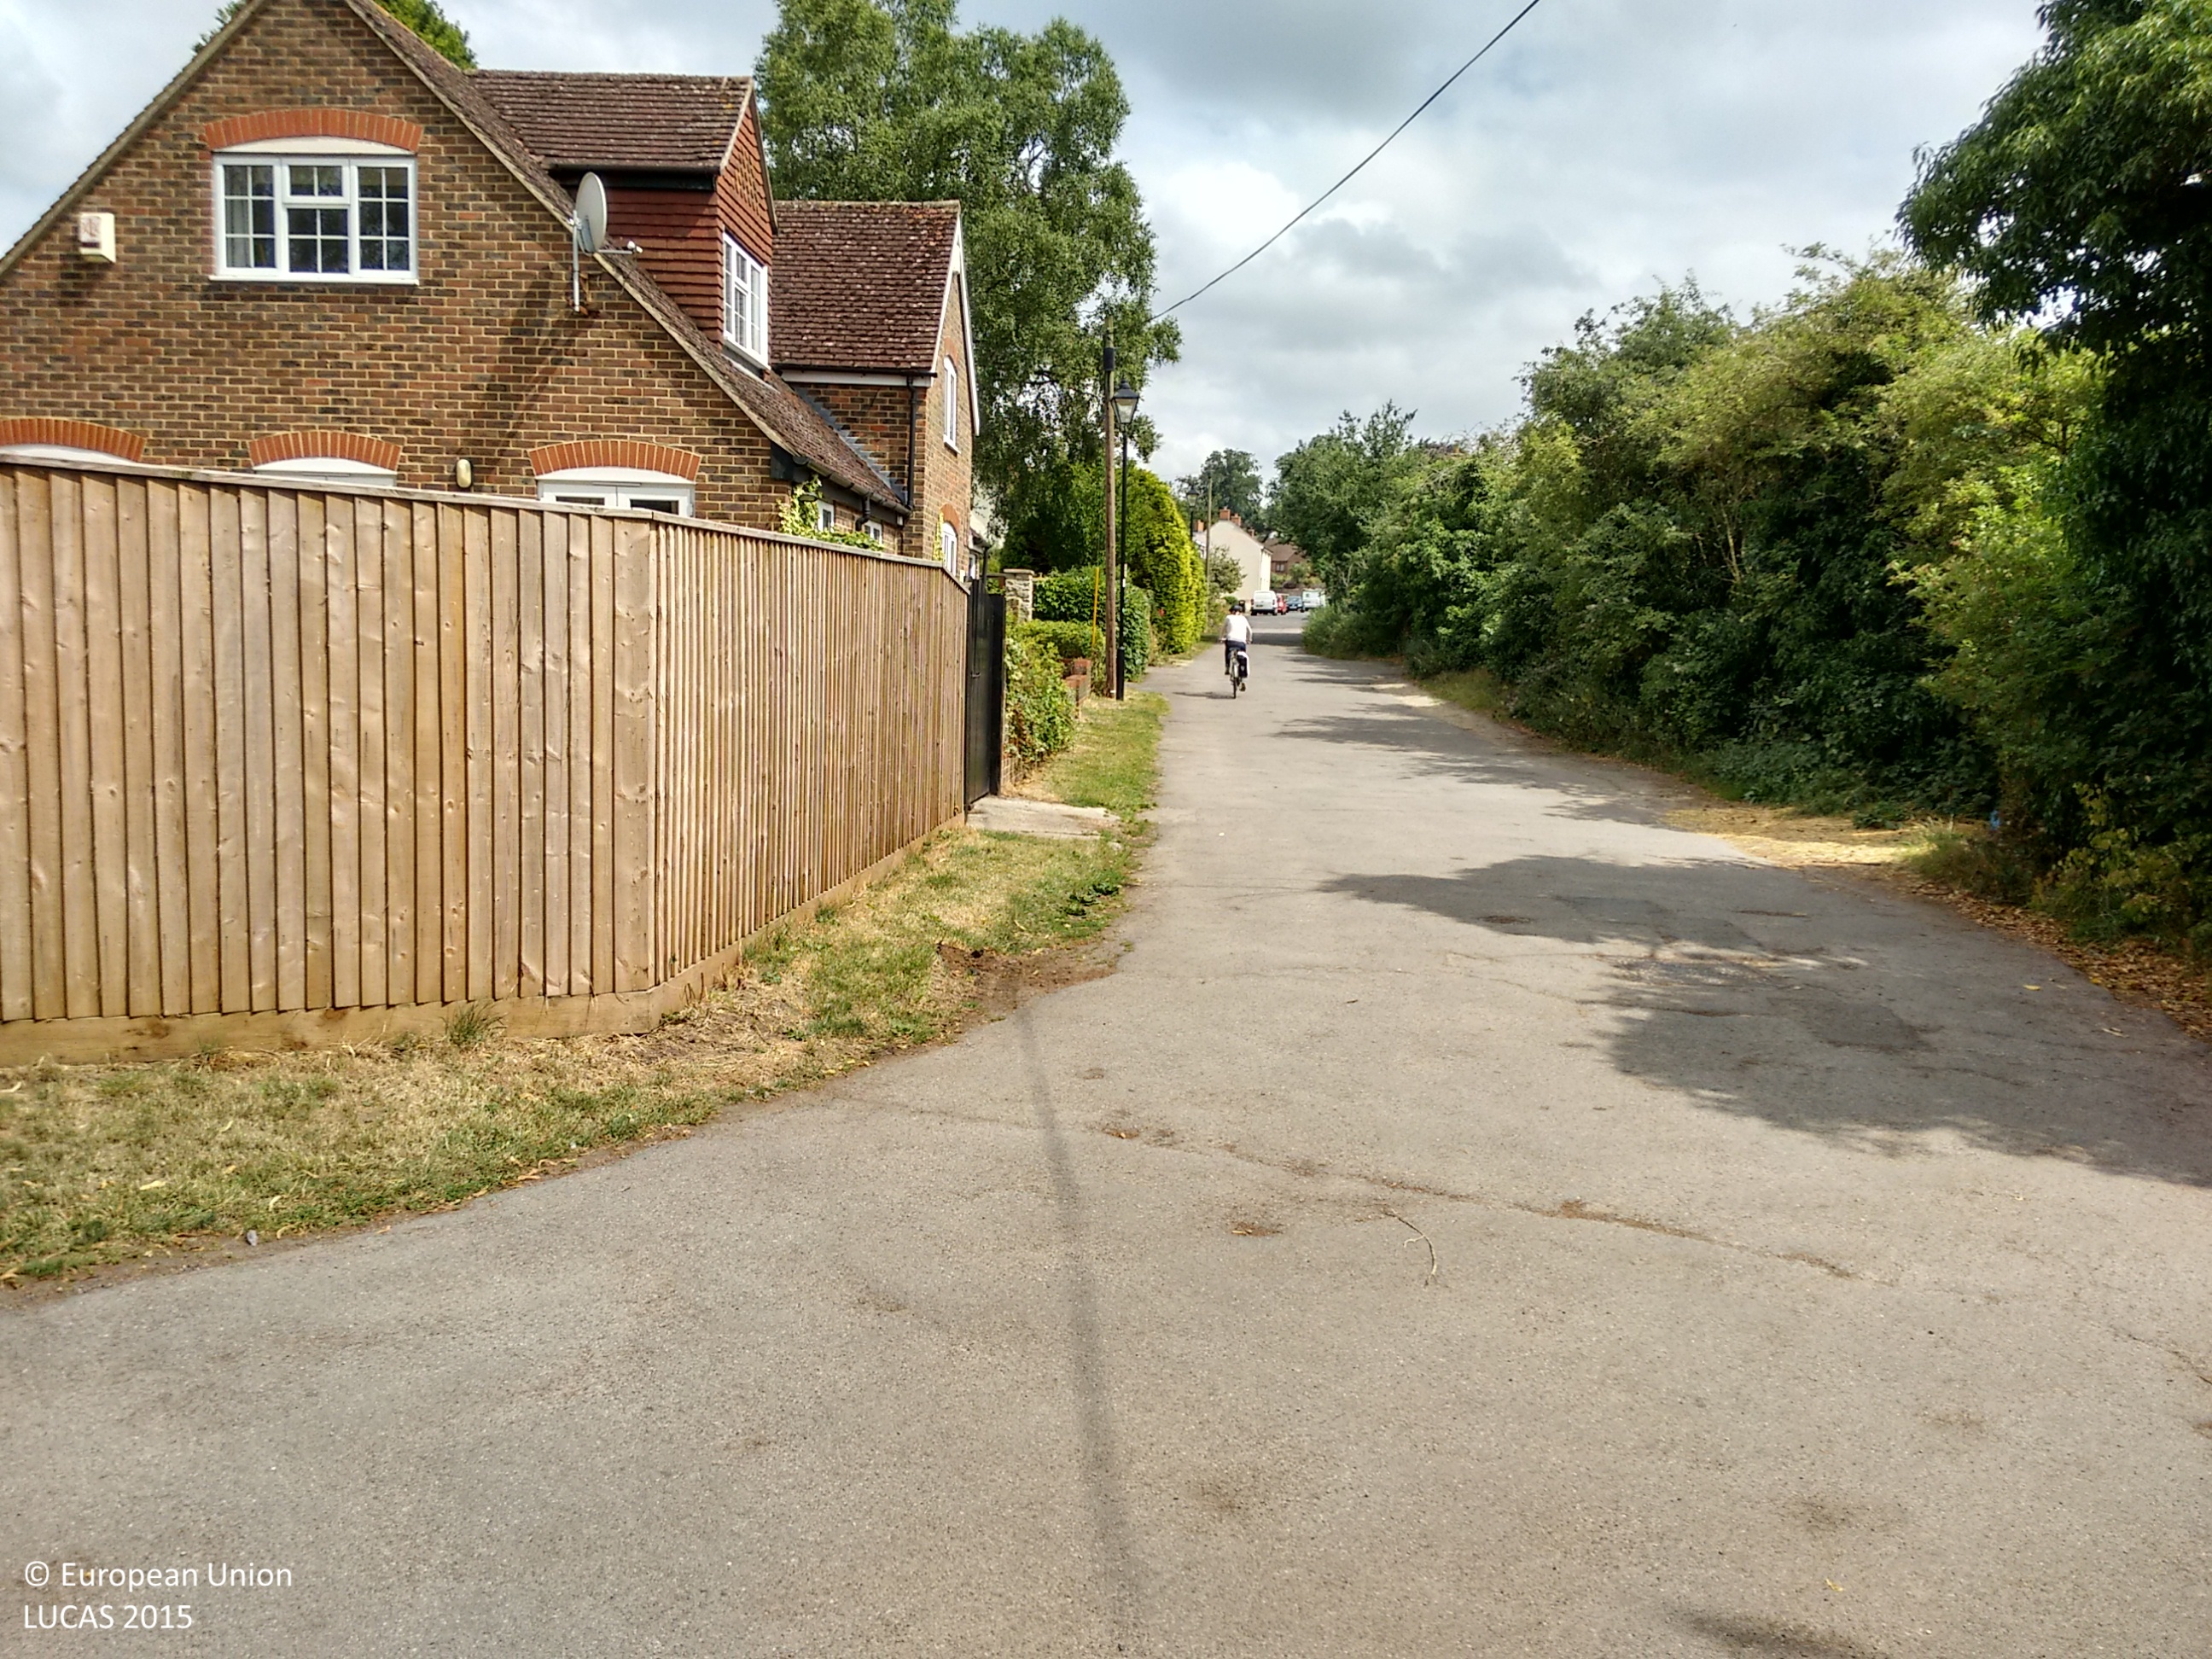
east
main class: Grassland
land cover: Grassland with sparse tree/shrub cover
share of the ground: > 75 %
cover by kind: herbaceous plants 95 %, broadleaved forest trees 5 %
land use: Agriculture (excluding fallow land and kitchen gardens)
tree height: > 5 m
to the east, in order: Grassland with sparse tree/shrub cover; Grassland without tree/shrub cover; Tracks; Broadleaved woodland; Fences; Grass margins; Artificial constructions in urban areas
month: July
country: GB
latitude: 51.7328
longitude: -1.2403
